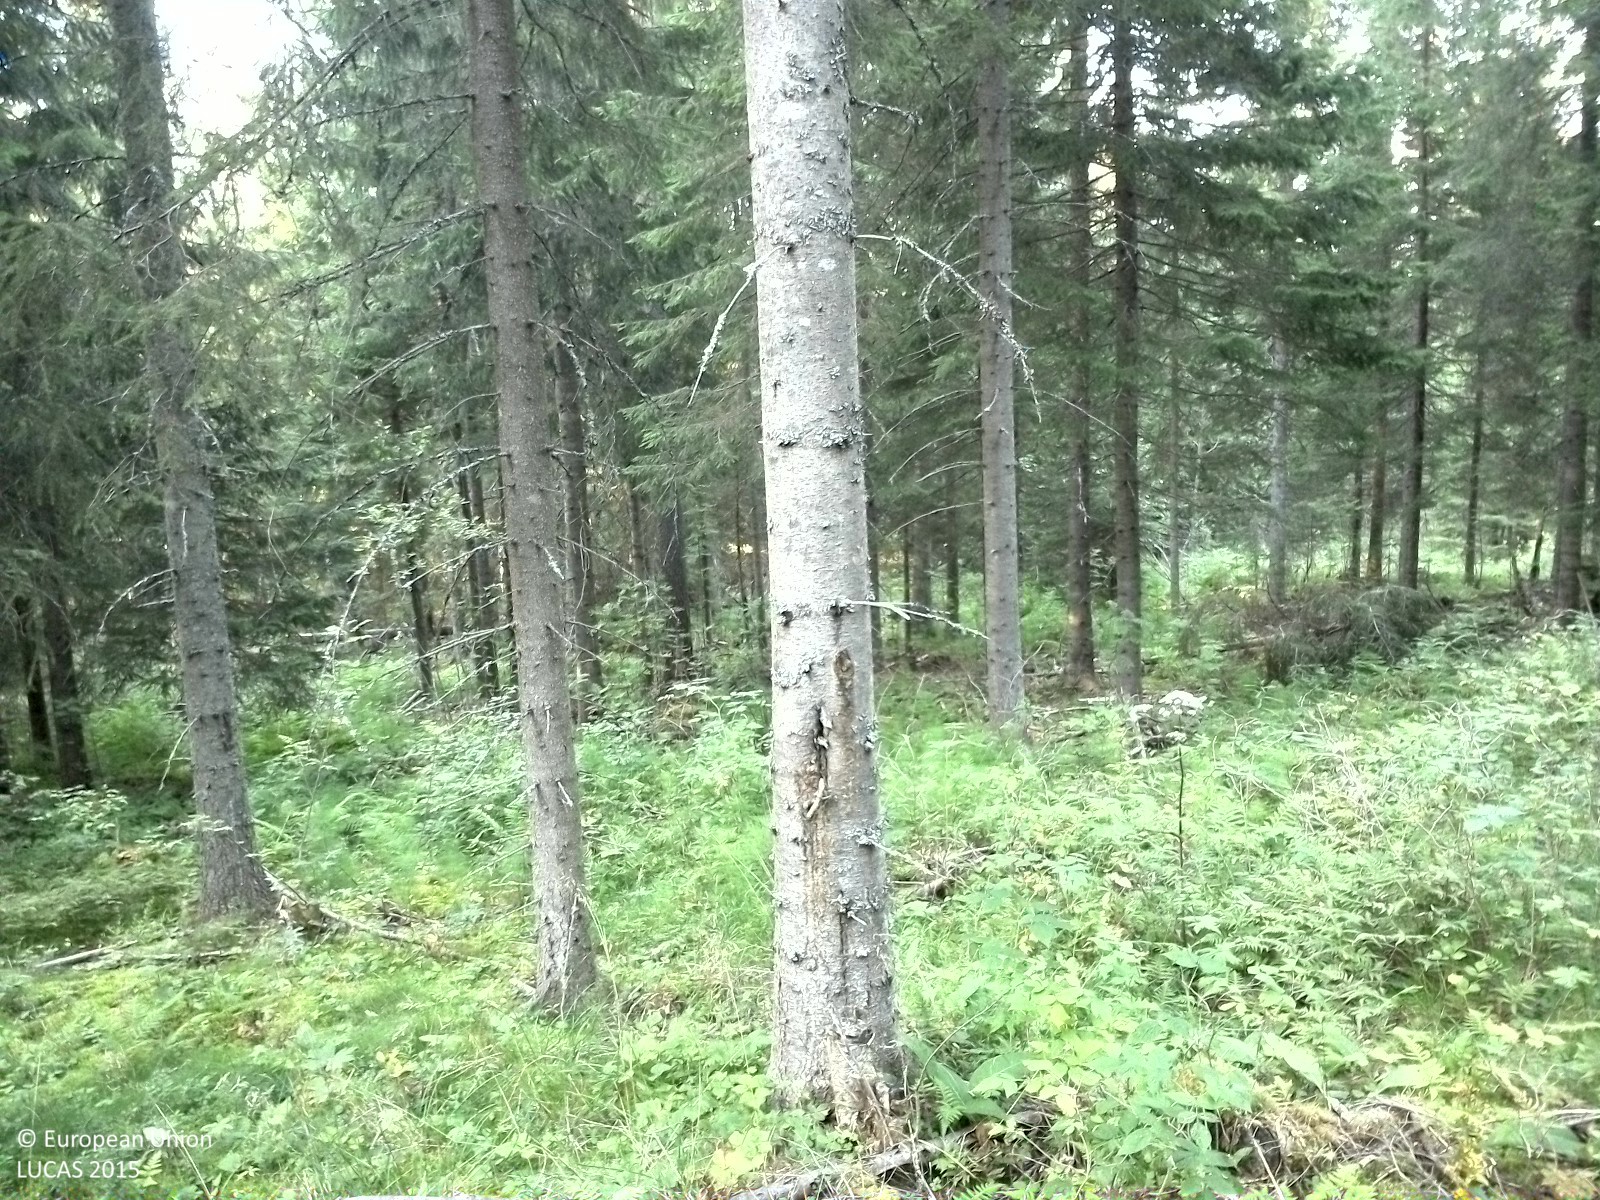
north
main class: Woodland
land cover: Spruce dominated mixed woodland
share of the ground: 25 - 50 %
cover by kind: herbaceous plants 50 %, coniferous forest trees 35 %, broadleaved forest trees 15 %
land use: Forestry
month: August
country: SE
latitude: 62.3108
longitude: 16.8671
